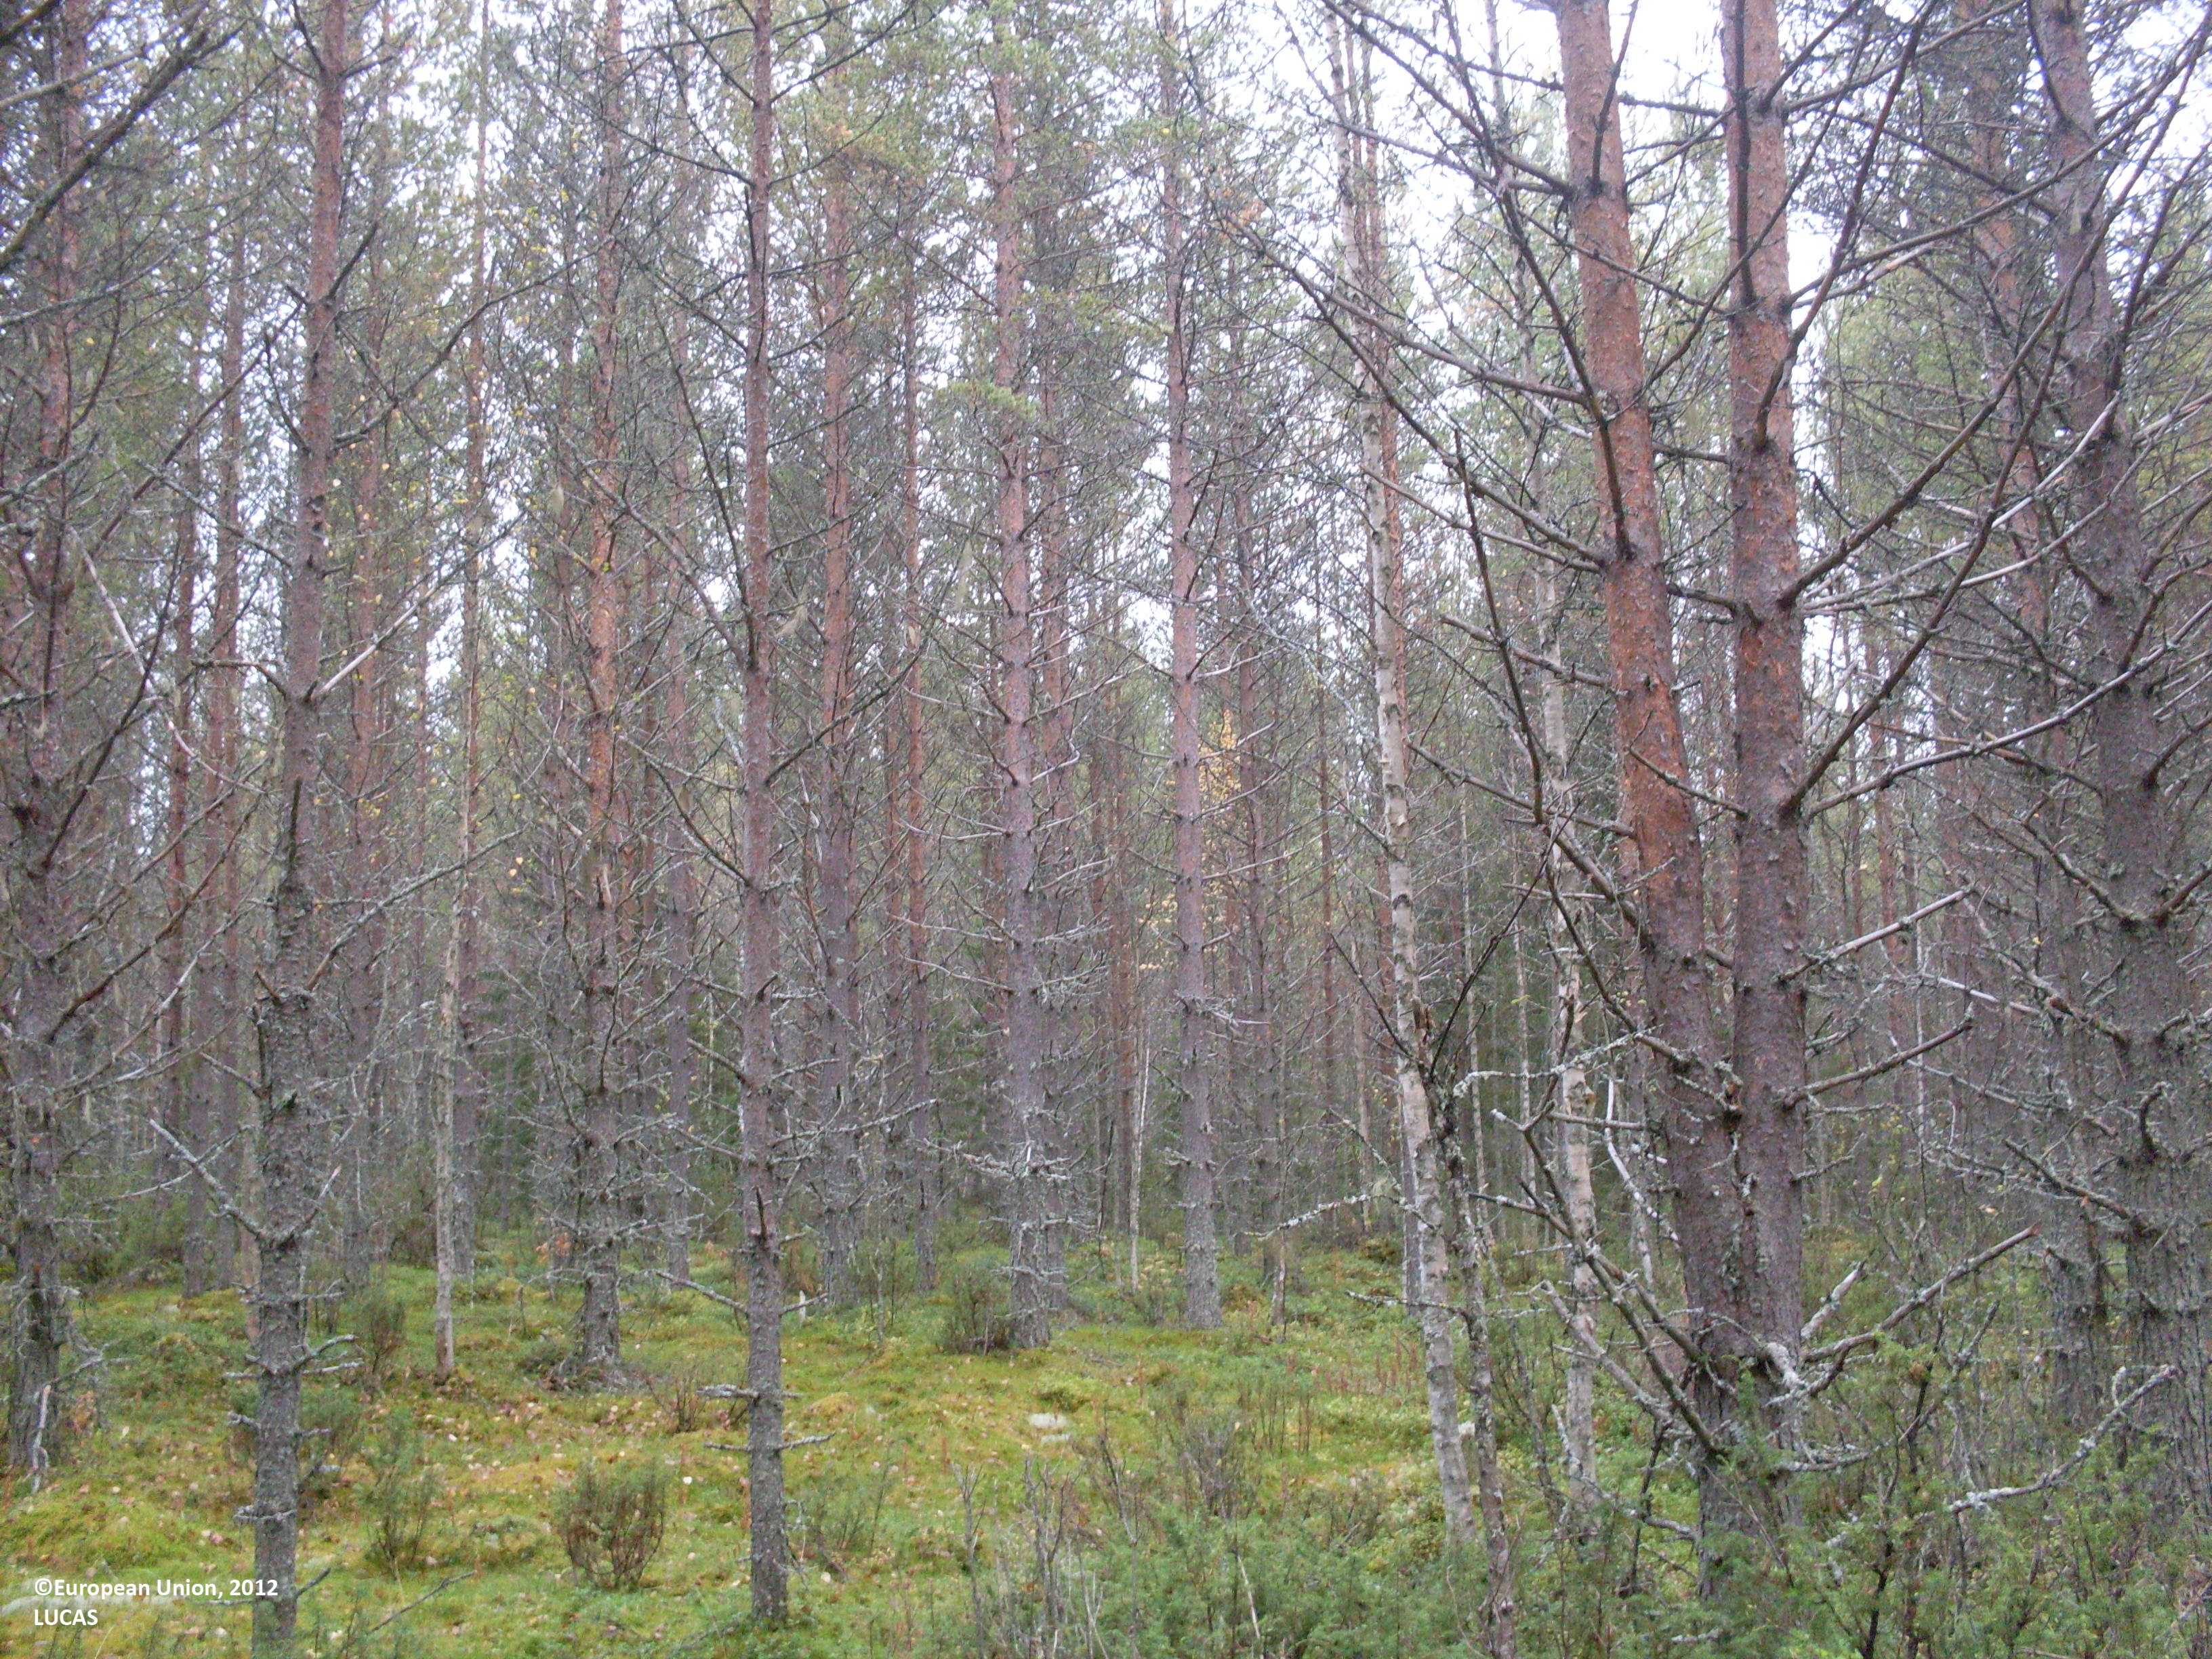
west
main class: Woodland
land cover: Pine dominated mixed woodland
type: boreal forest
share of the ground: 50 - 75 %
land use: Forestry
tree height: > 5 m
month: September
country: FI
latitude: 64.5670
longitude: 28.4769
